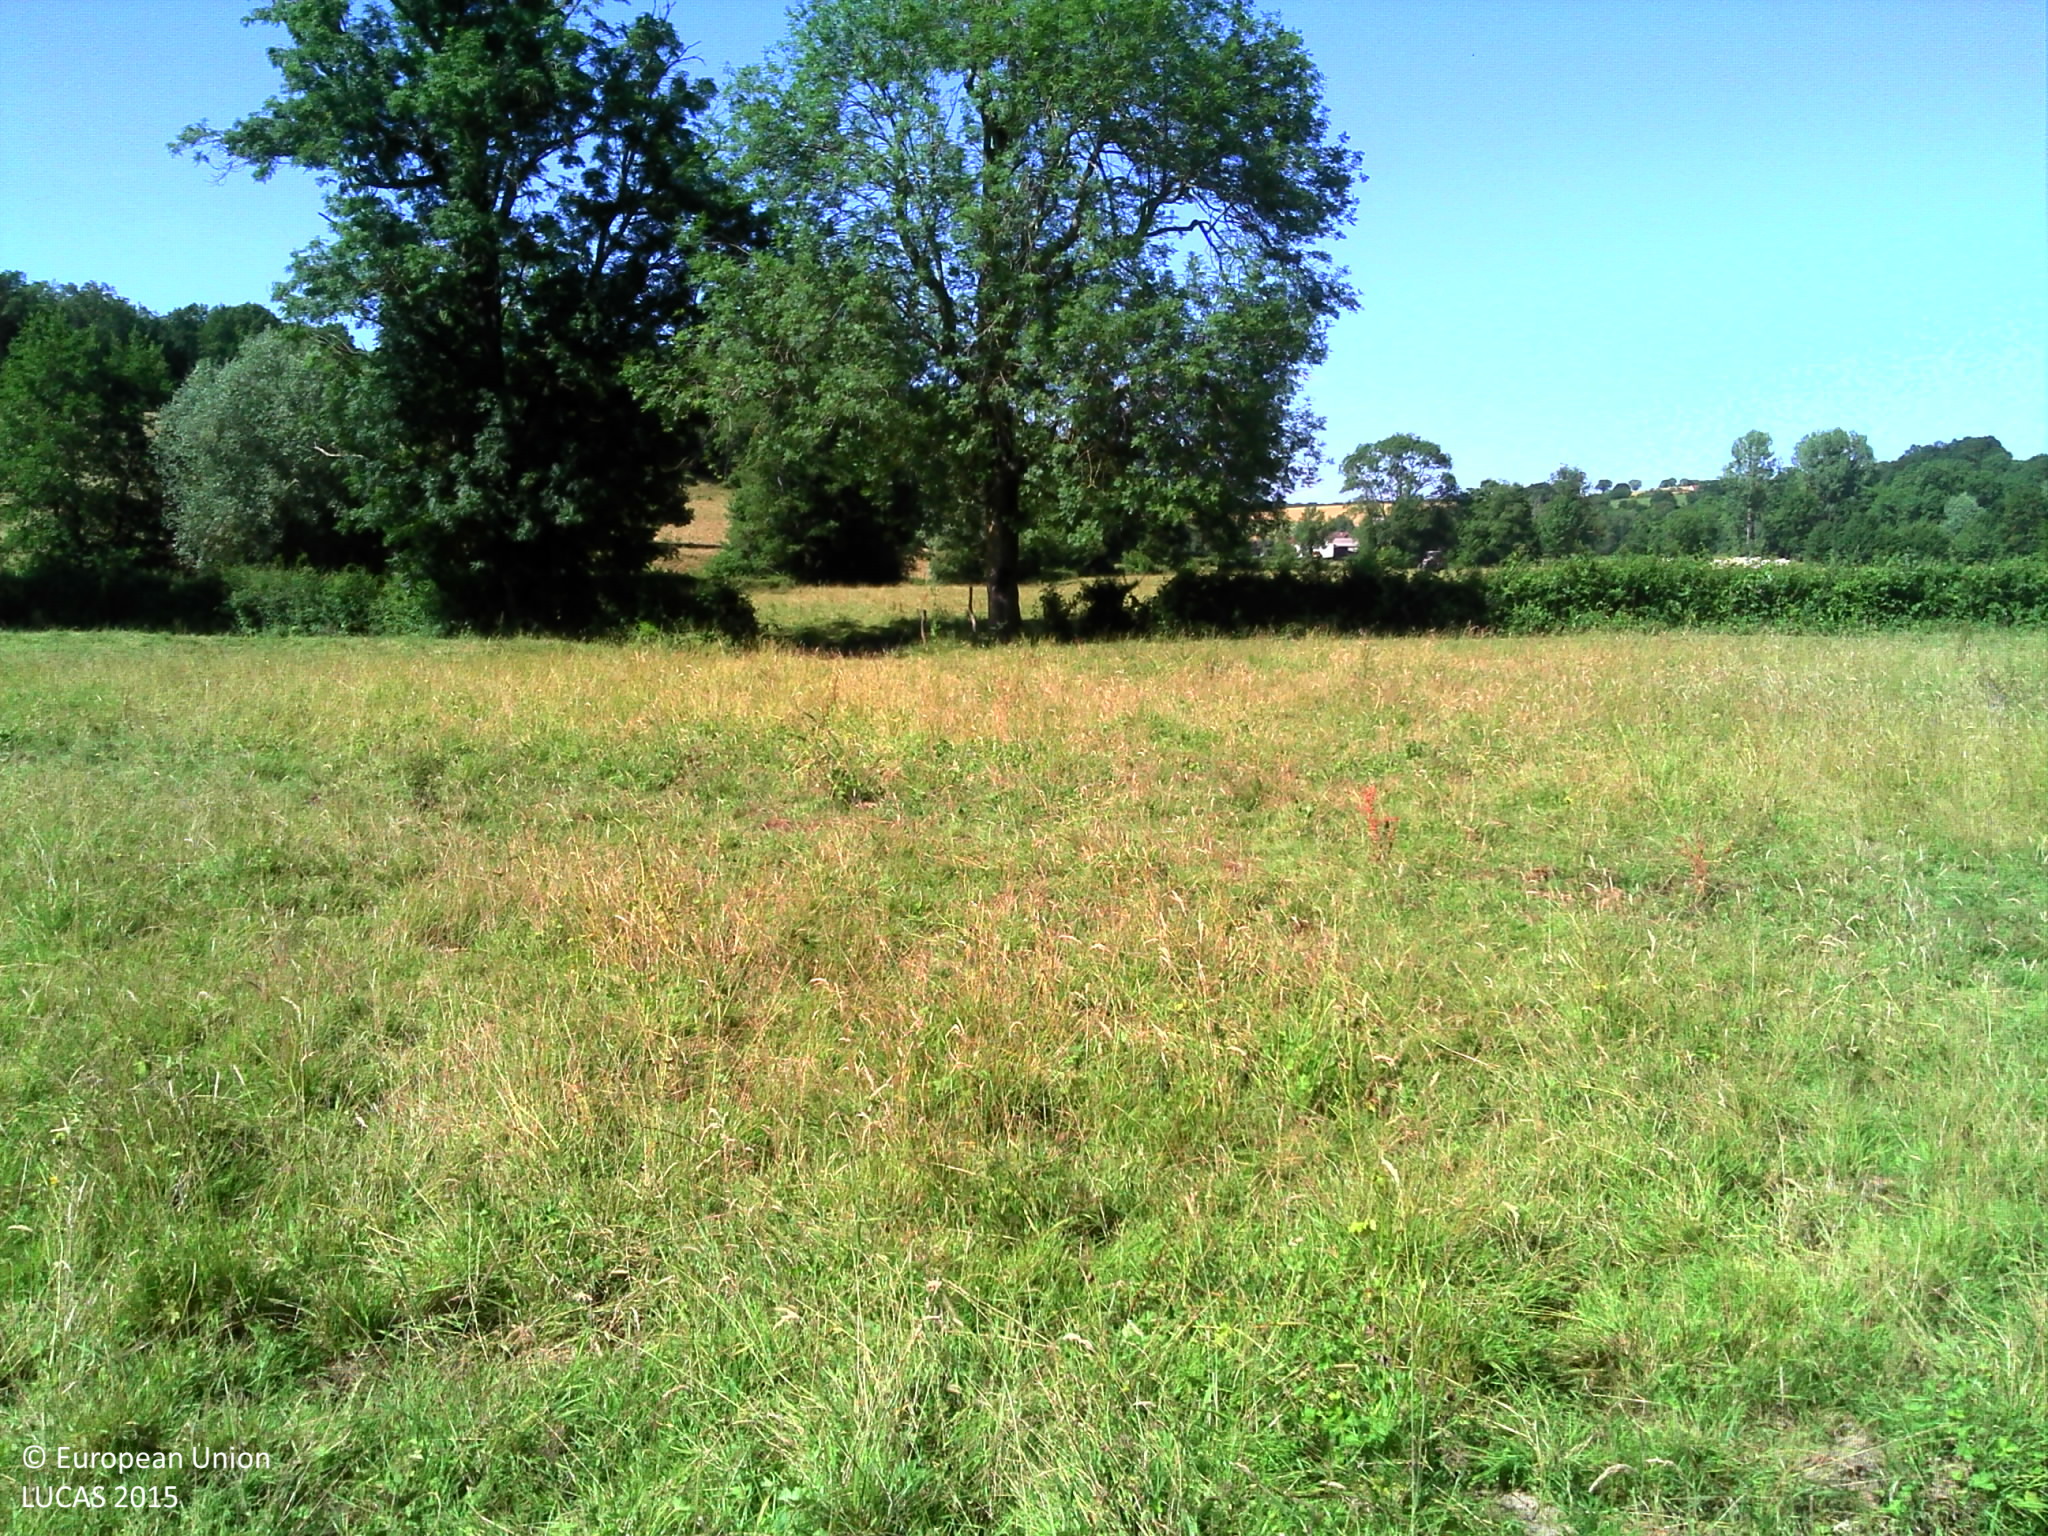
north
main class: Grassland
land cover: Grassland without tree/shrub cover
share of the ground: > 75 %
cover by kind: herbaceous plants 100 %
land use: Agriculture (excluding fallow land and kitchen gardens)
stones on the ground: < 10 %
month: June
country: FR
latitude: 47.3634
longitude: 3.4952
